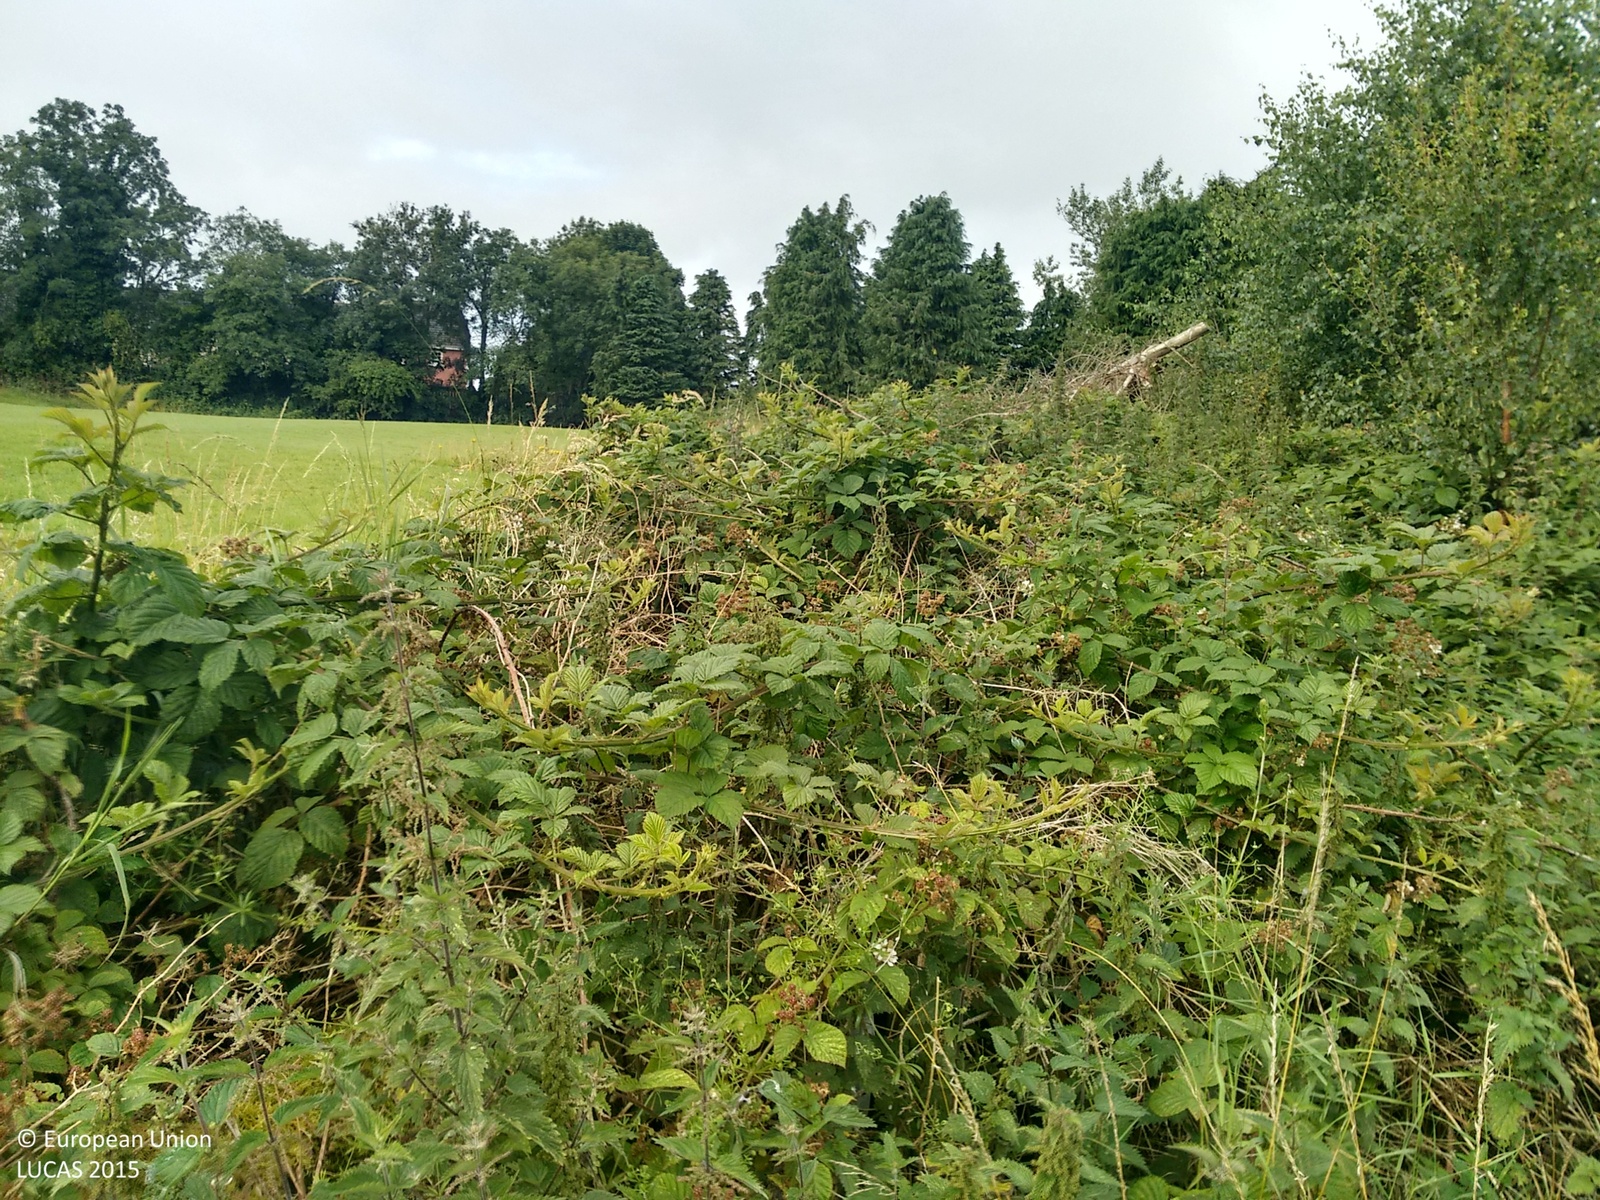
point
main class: Woodland
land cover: Pine dominated mixed woodland
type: exotic forest
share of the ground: > 75 %
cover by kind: coniferous forest trees 75 %, broadleaved forest trees 25 %
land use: Residential
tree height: > 5 m
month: August
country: GB
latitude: 54.1944
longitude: -6.3208
